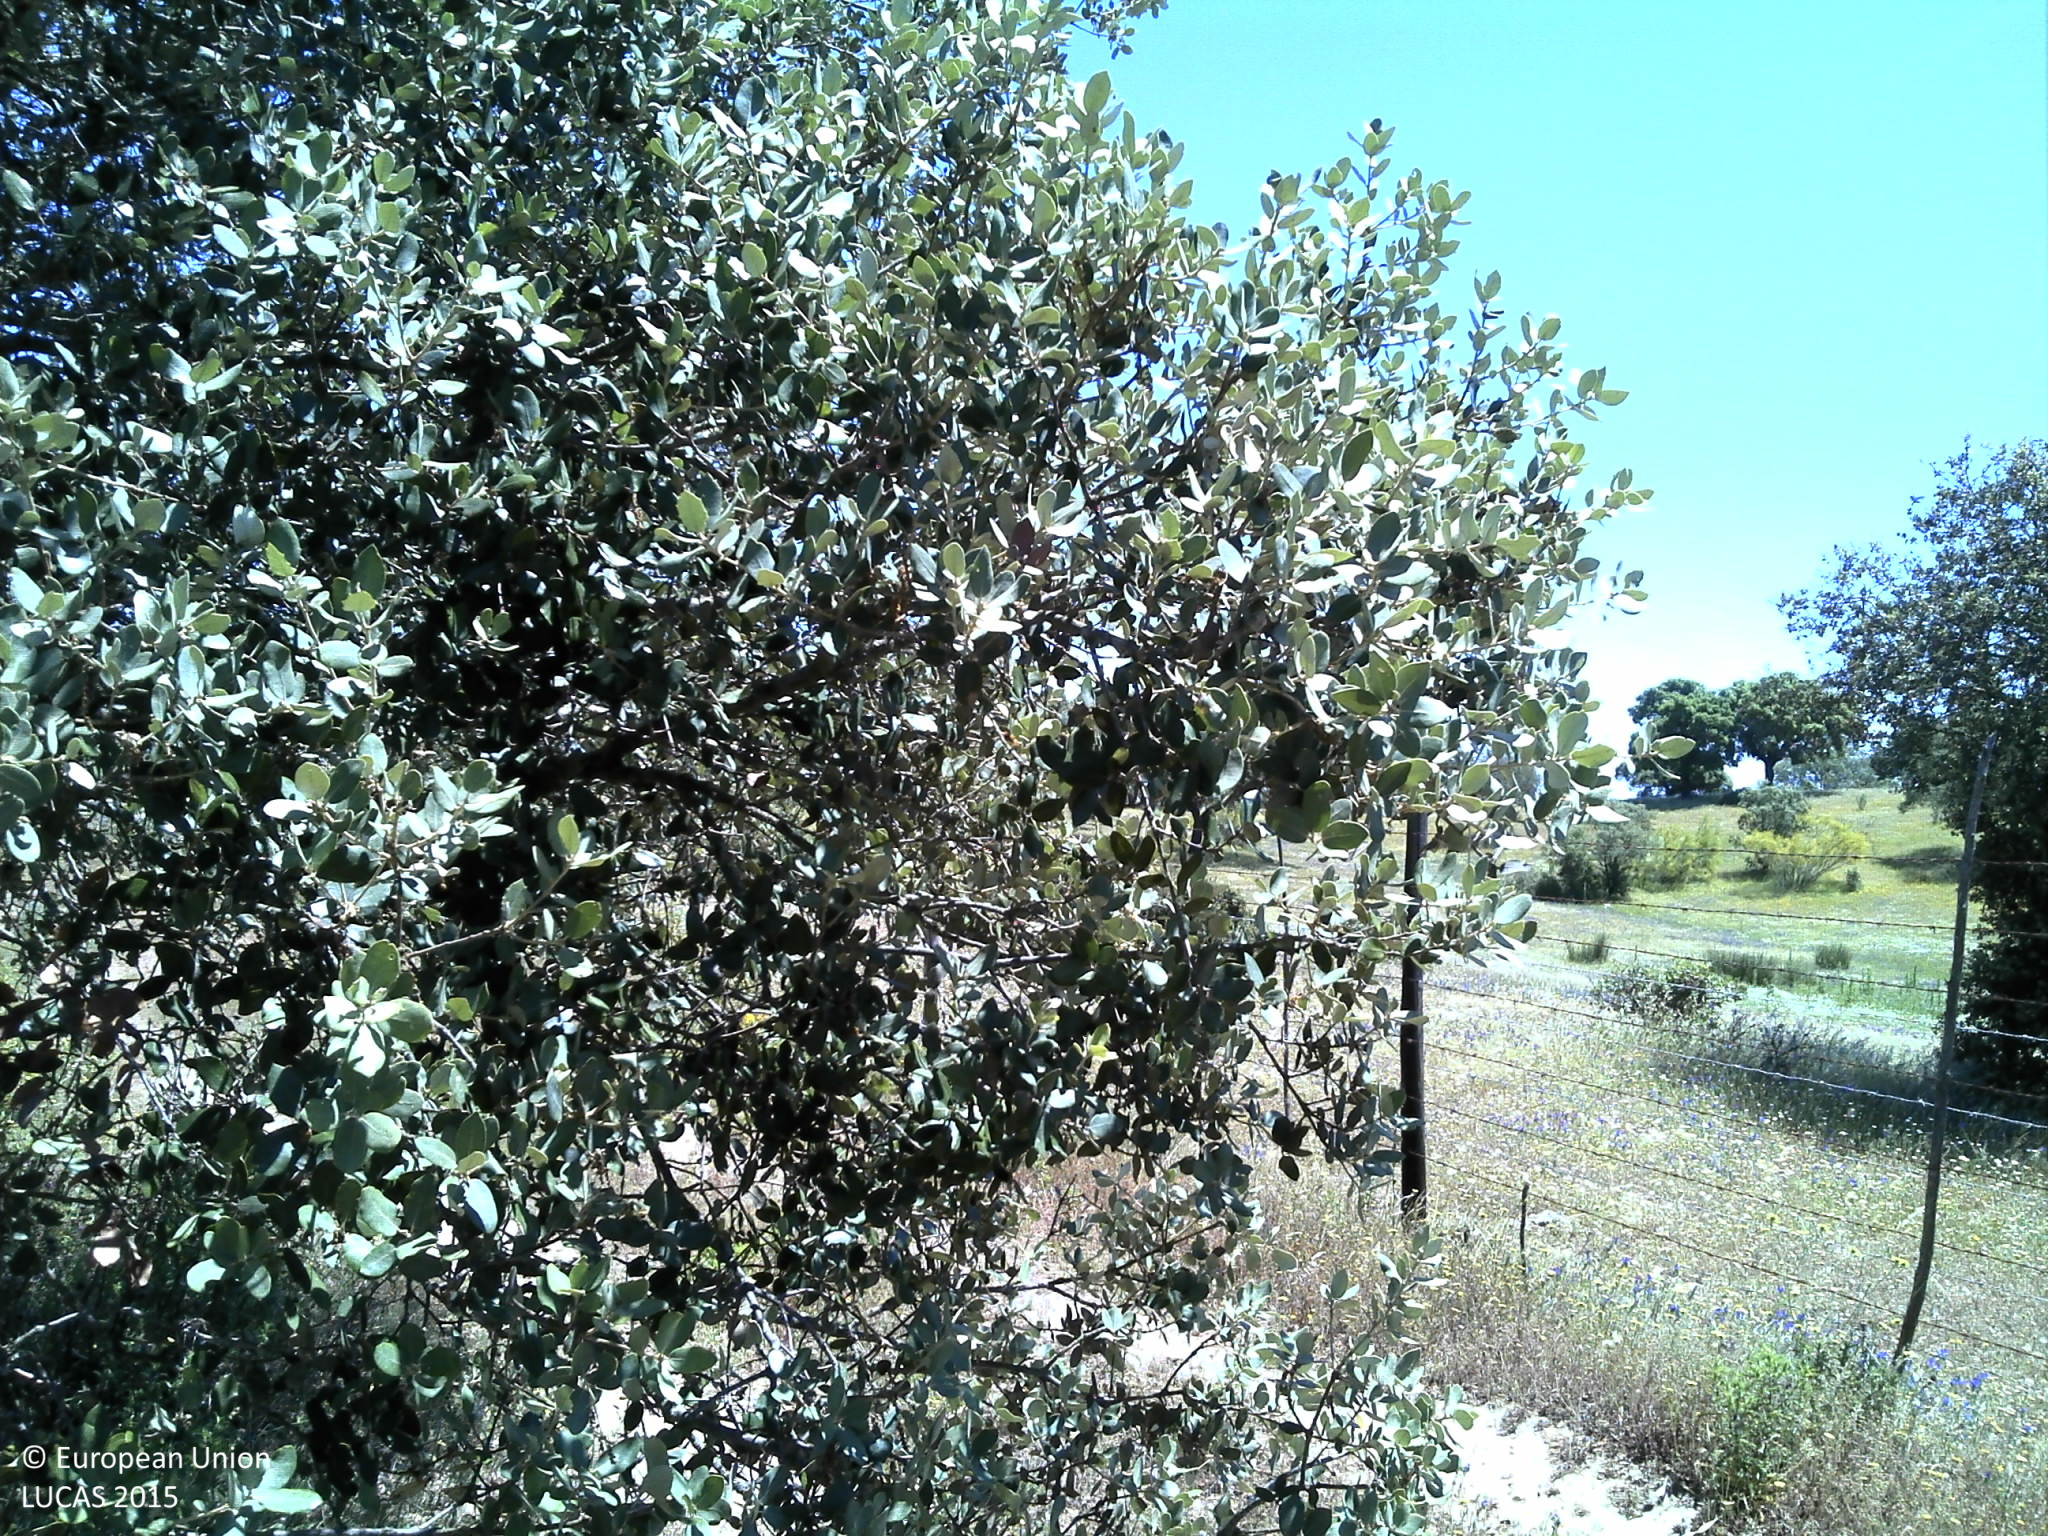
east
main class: Woodland
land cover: Broadleaved woodland
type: broadleaved evergreen forest
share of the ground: 10 - 25 %
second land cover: Grassland without tree/shrub cover
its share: 25 - 50 %
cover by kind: broadleaved forest trees 25 %, shrubs 25 %, herbaceous plants 25 %, unconsolidated bare surface 25 %
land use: Forestry
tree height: > 5 m
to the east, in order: Broadleaved woodland; Grassland without tree/shrub cover; Tracks; Grass margins; Fences; Grassland with sparse tree/shrub cover; Broadleaved woodland; Grassland with sparse tree/shrub cover; Broadleaved woodland; Fences; Broadleaved woodland
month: May
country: PT
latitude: 39.2068
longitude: -7.8492
